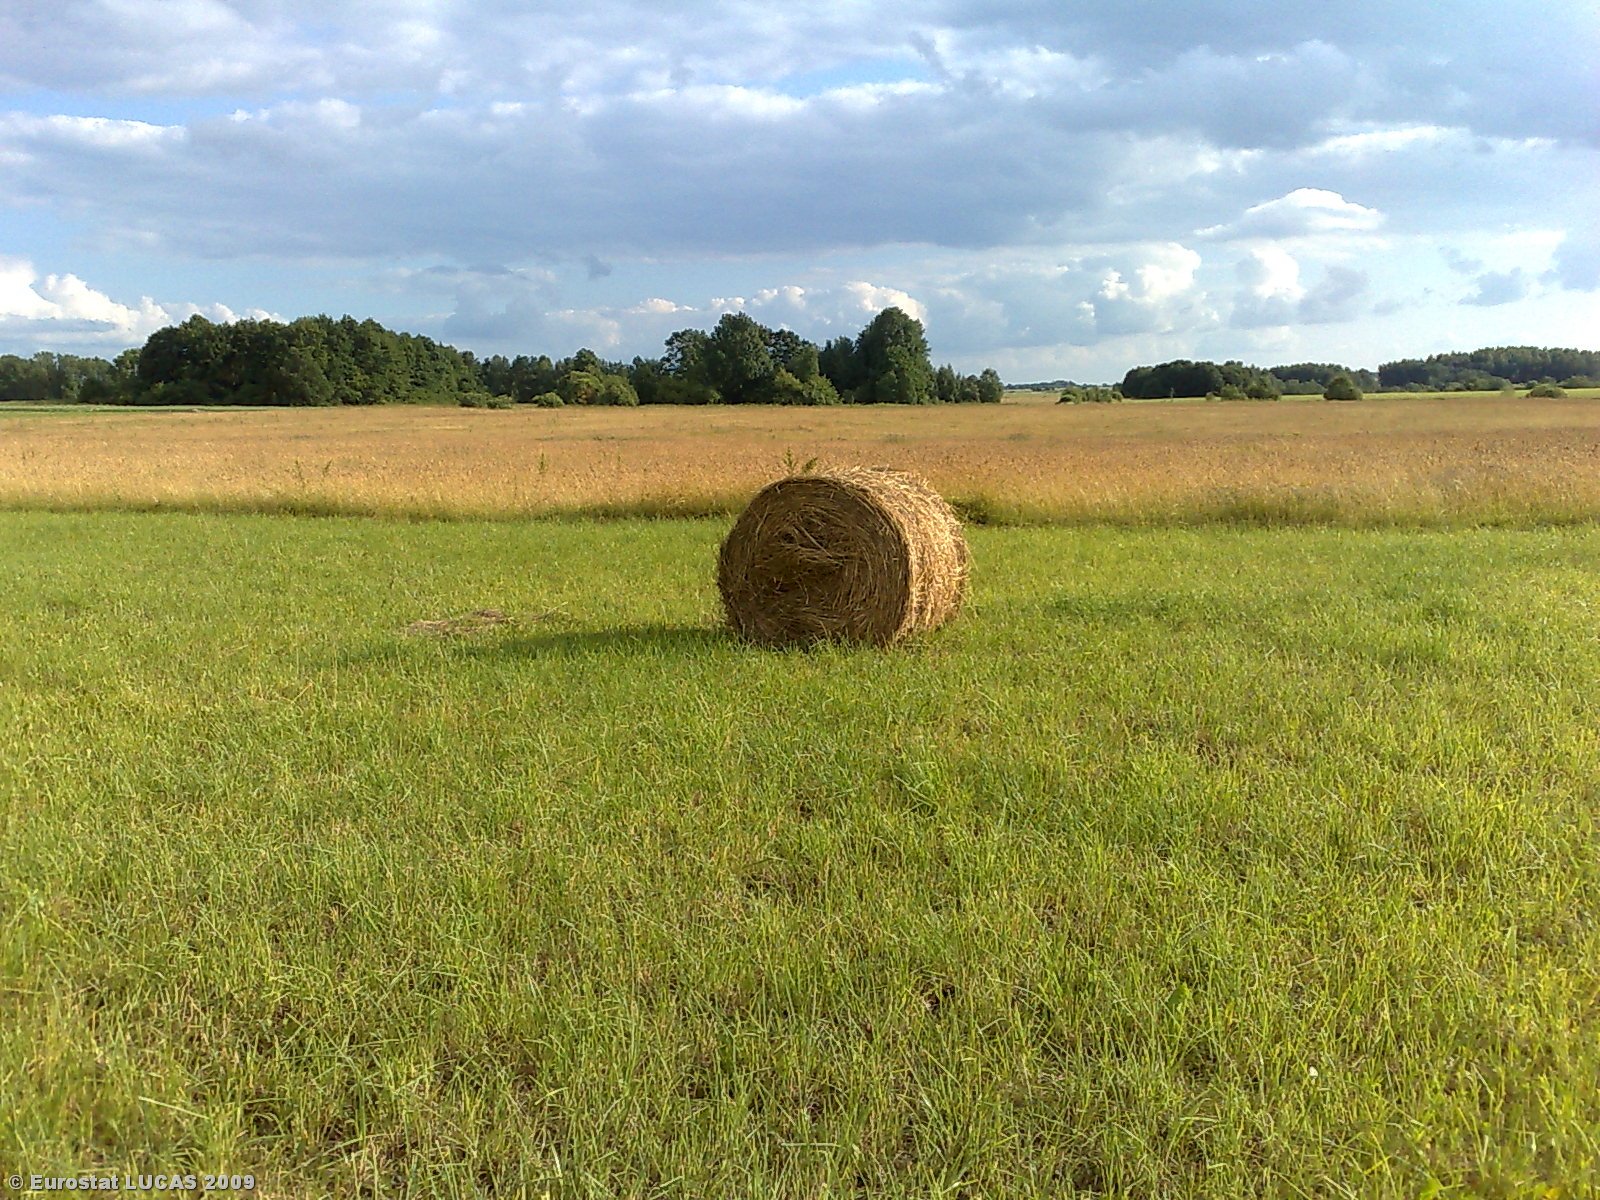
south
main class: Grassland
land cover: Grassland without tree/shrub cover
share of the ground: > 75 %
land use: Agriculture (excluding fallow land and kitchen gardens)
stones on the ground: < 10 %
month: July
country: LT
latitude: 55.7269
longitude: 22.7872
